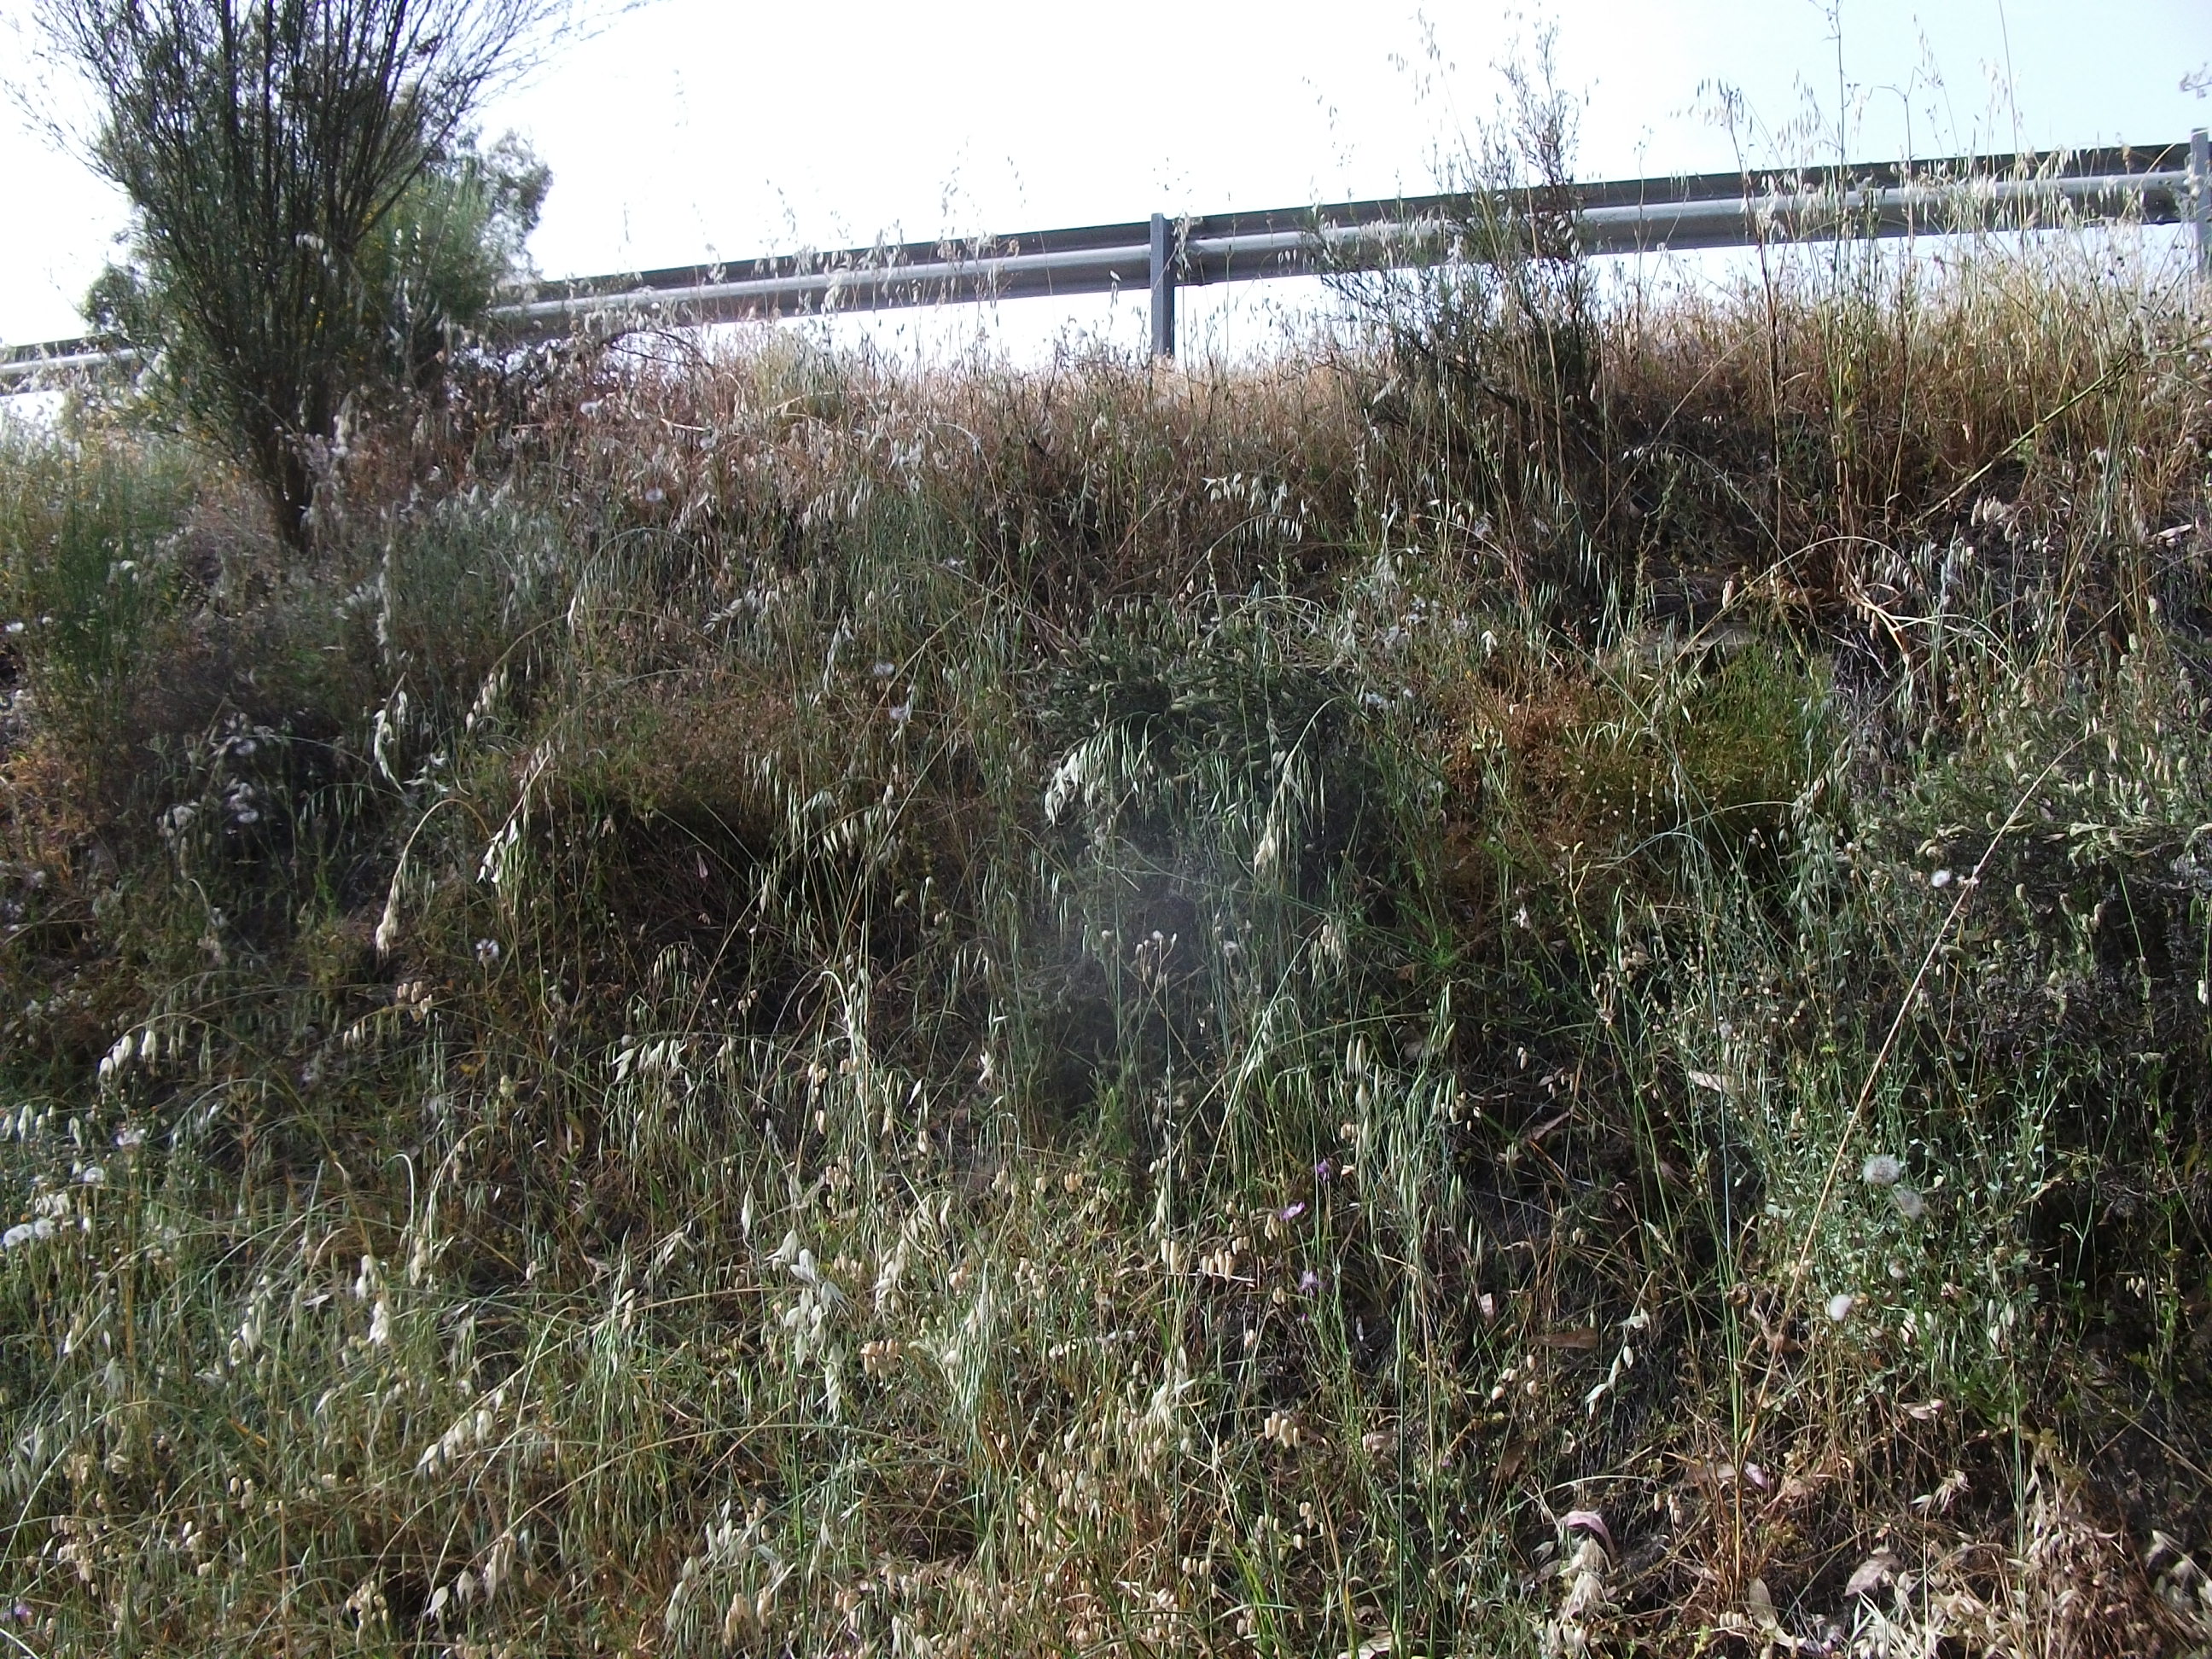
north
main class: Woodland
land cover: Broadleaved woodland
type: exotic forest
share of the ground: 10 - 25 %
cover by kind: herbaceous plants 80 %, broadleaved forest trees 20 %
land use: Semi-natural and natural areas not in use
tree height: > 5 m
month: May
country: ES
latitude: 37.6906
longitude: -6.9557
